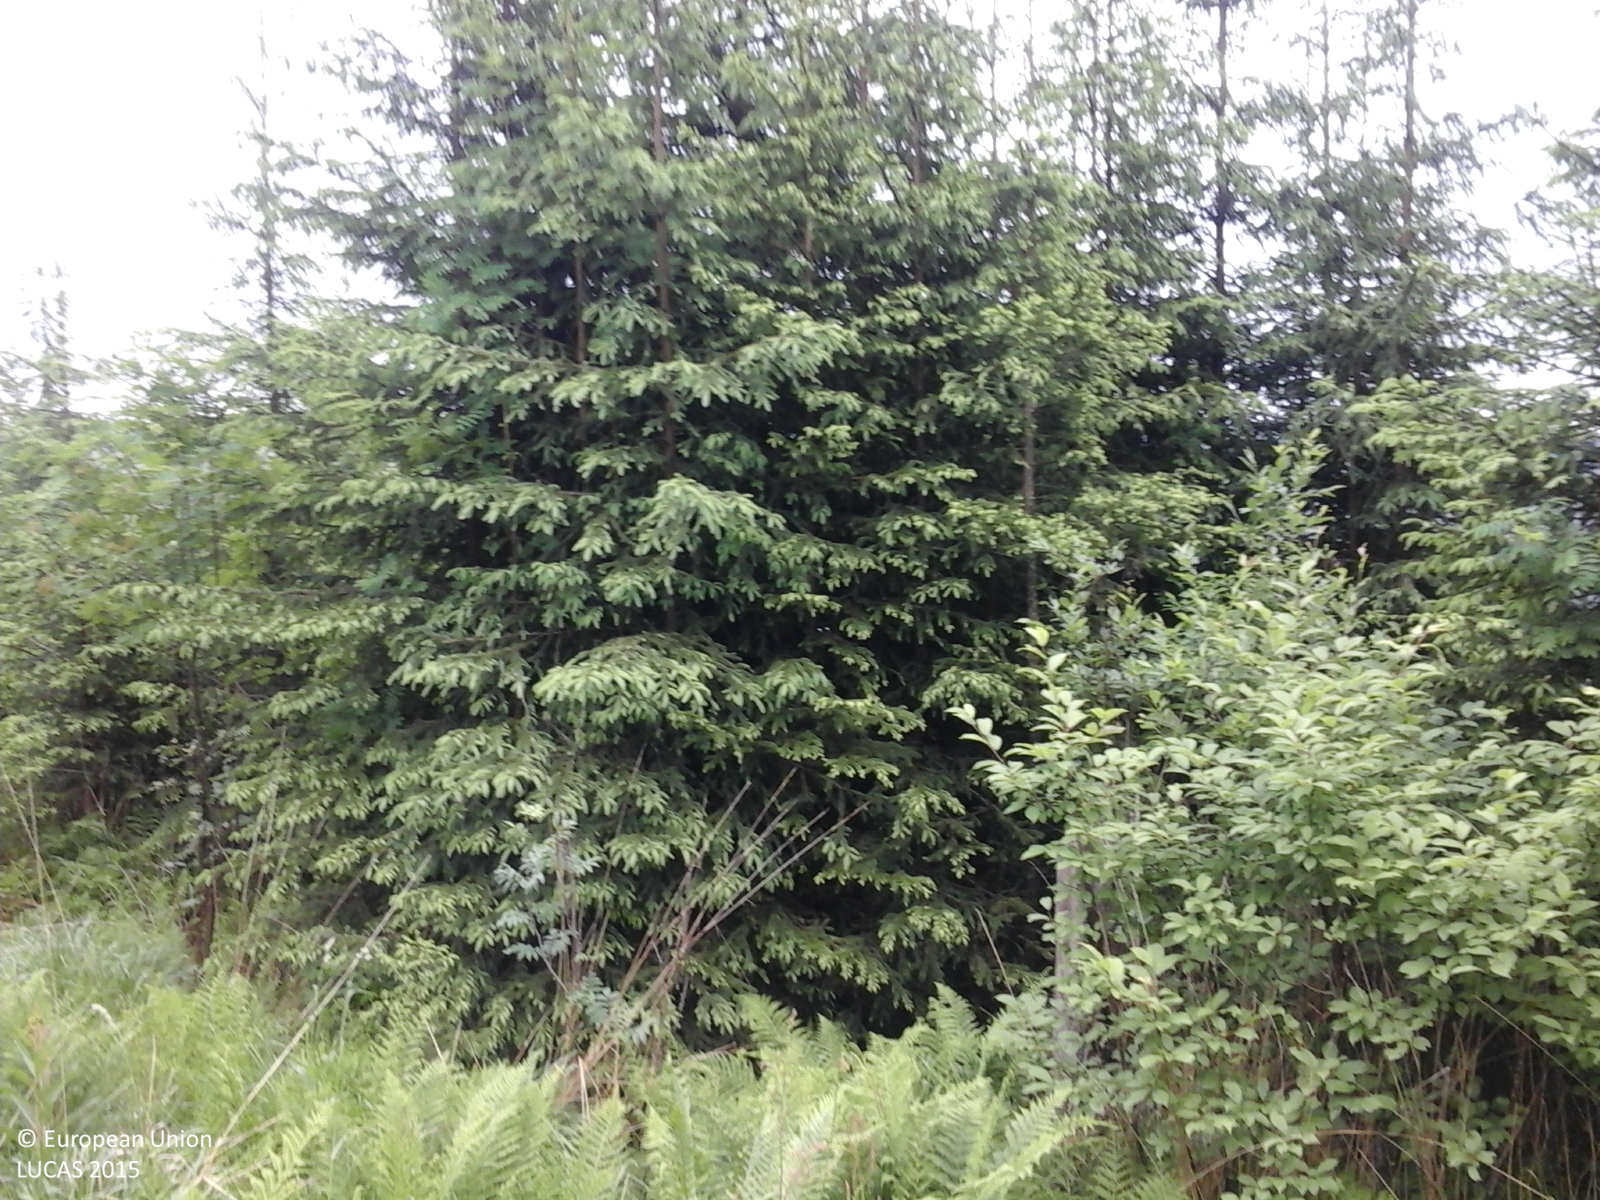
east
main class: Woodland
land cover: Spruce dominated coniferous woodland
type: alpine coniferous forest
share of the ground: > 75 %
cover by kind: coniferous forest trees 75 %, broadleaved forest trees 10 %, herbaceous plants 10 %, shrubs 5 %
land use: Forestry
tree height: > 5 m
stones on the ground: 25 - 50 %
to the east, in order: Spruce dominated coniferous woodland; Grassland without tree/shrub cover; Lines of trees; Grassland without tree/shrub cover; Lines of trees; Fences; Grassland without tree/shrub cover; Fences; Lines of trees; Grassland without tree/shrub cover
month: June
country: RO
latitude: 47.4550
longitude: 25.3253
